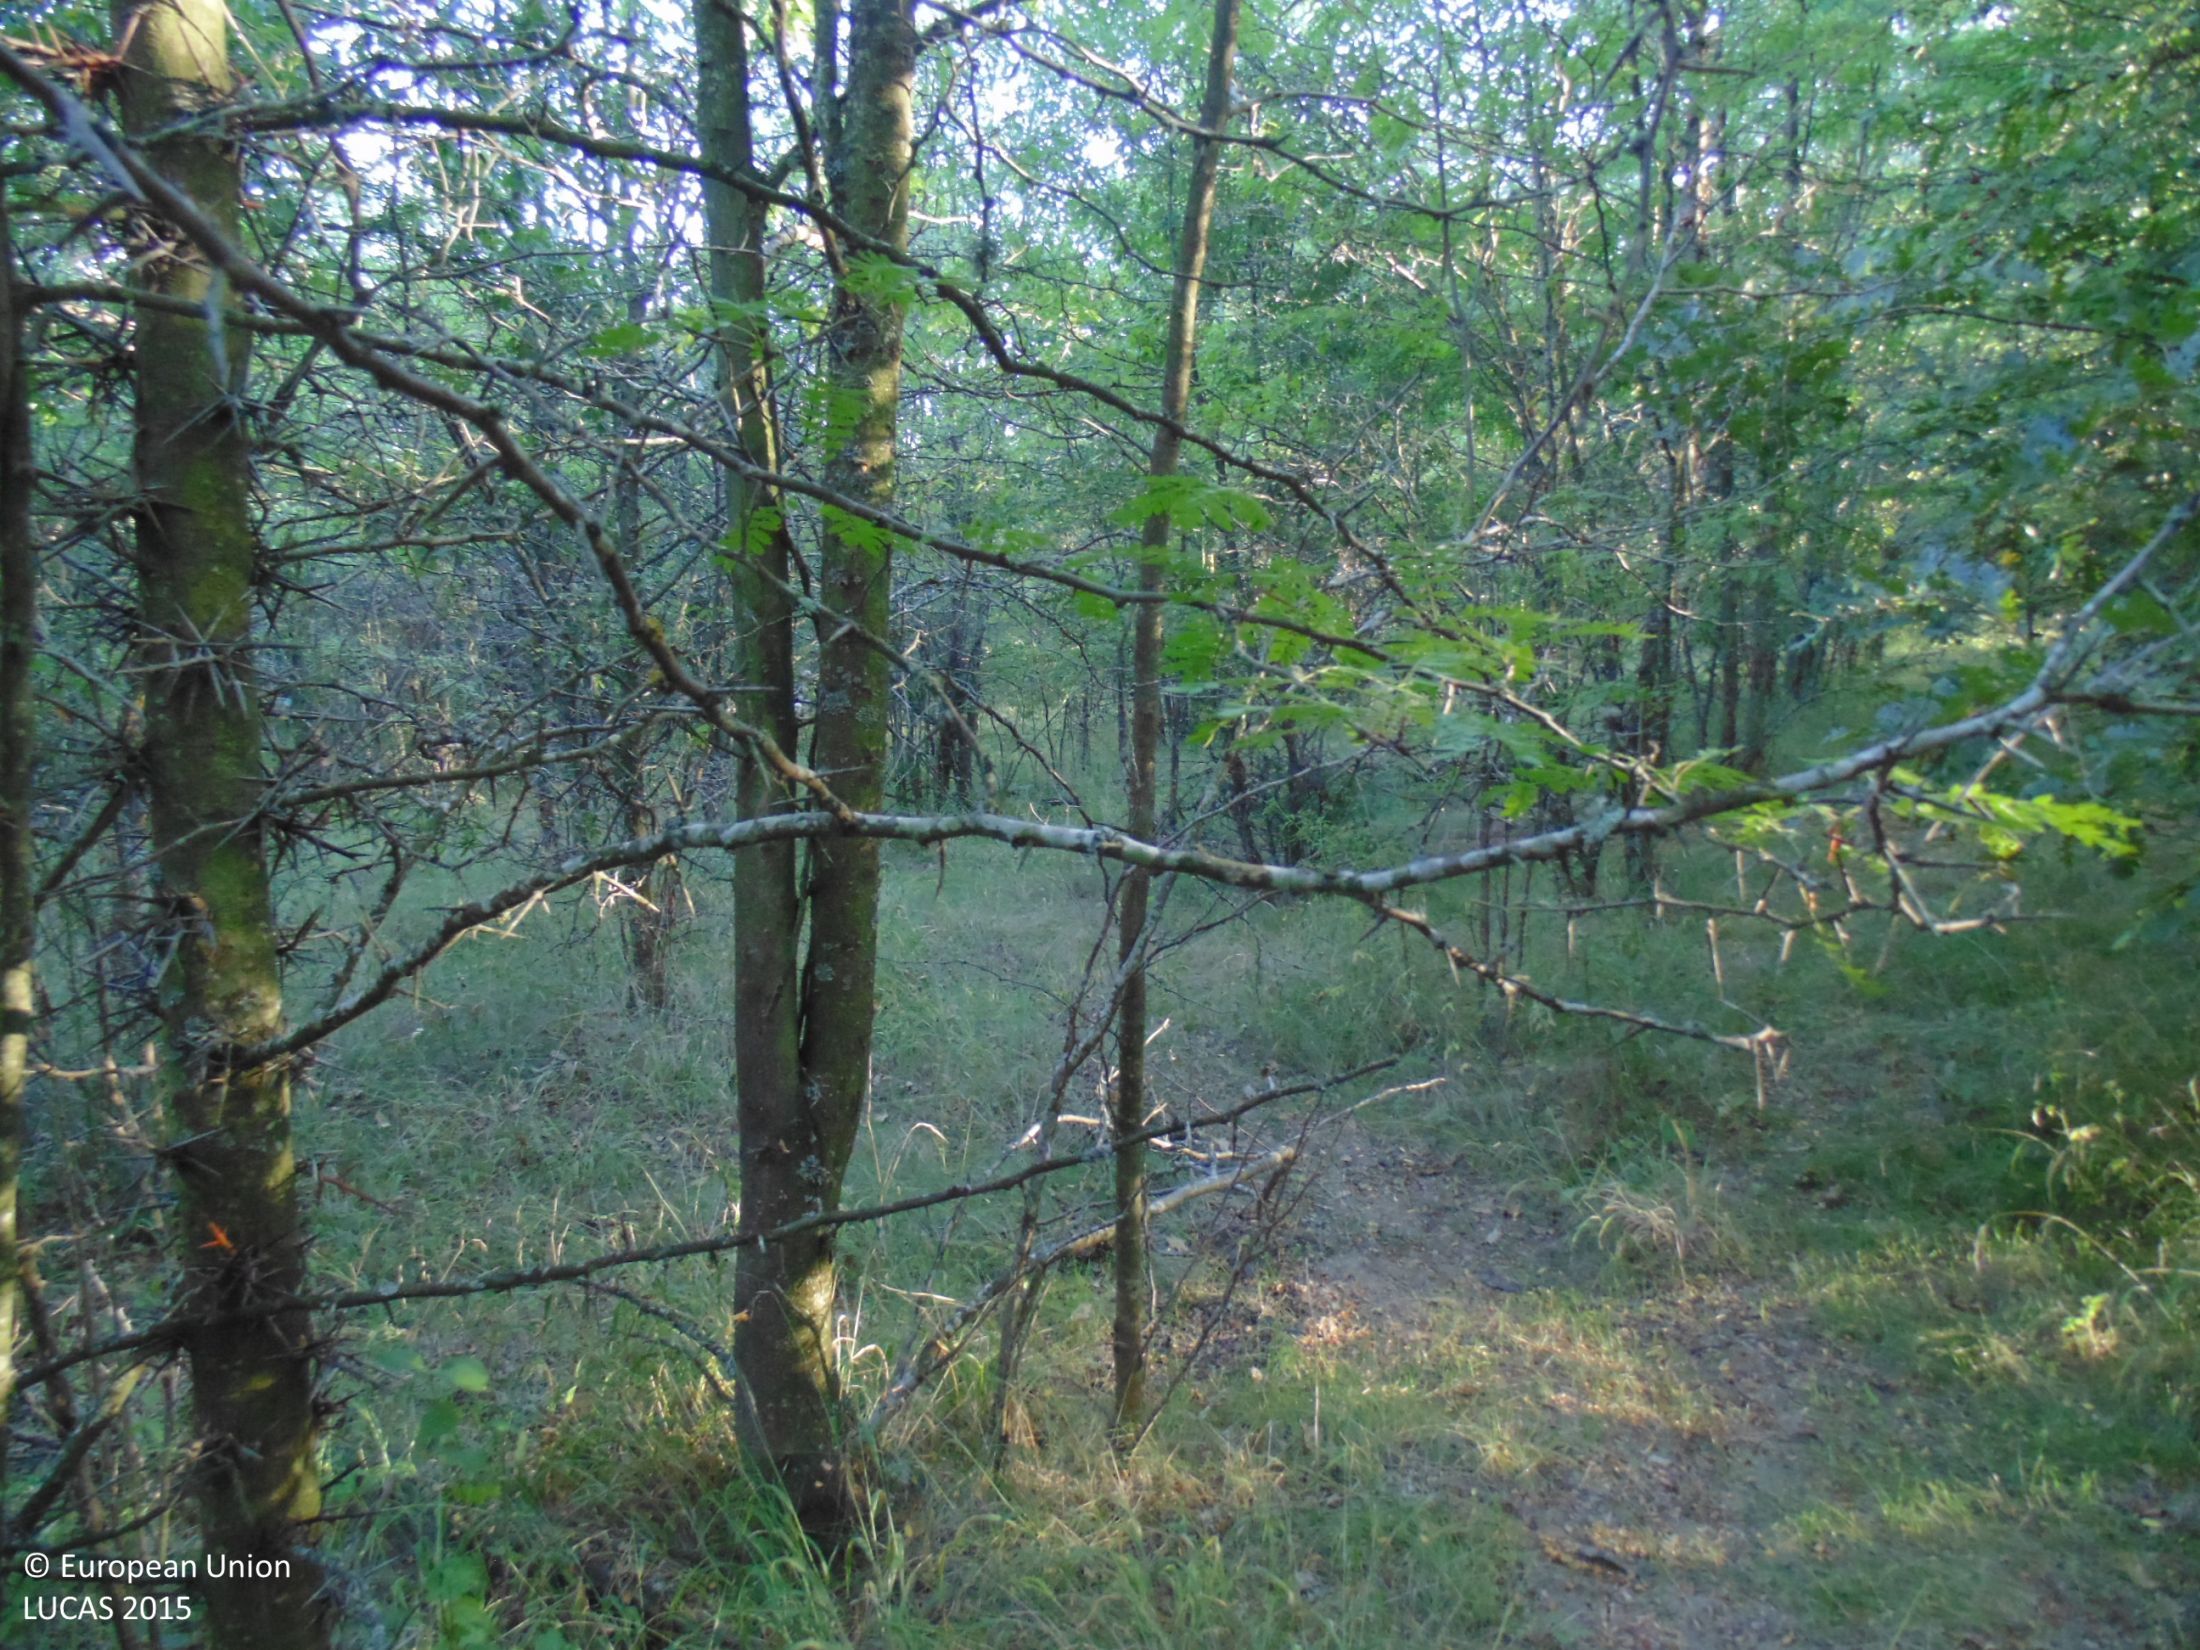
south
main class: Woodland
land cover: Broadleaved woodland
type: mesophytic deciduous forest
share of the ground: > 75 %
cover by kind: broadleaved forest trees 95 %, unconsolidated bare surface 5 %
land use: Forestry
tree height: > 5 m
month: September
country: BG
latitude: 43.7921
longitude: 27.2657
